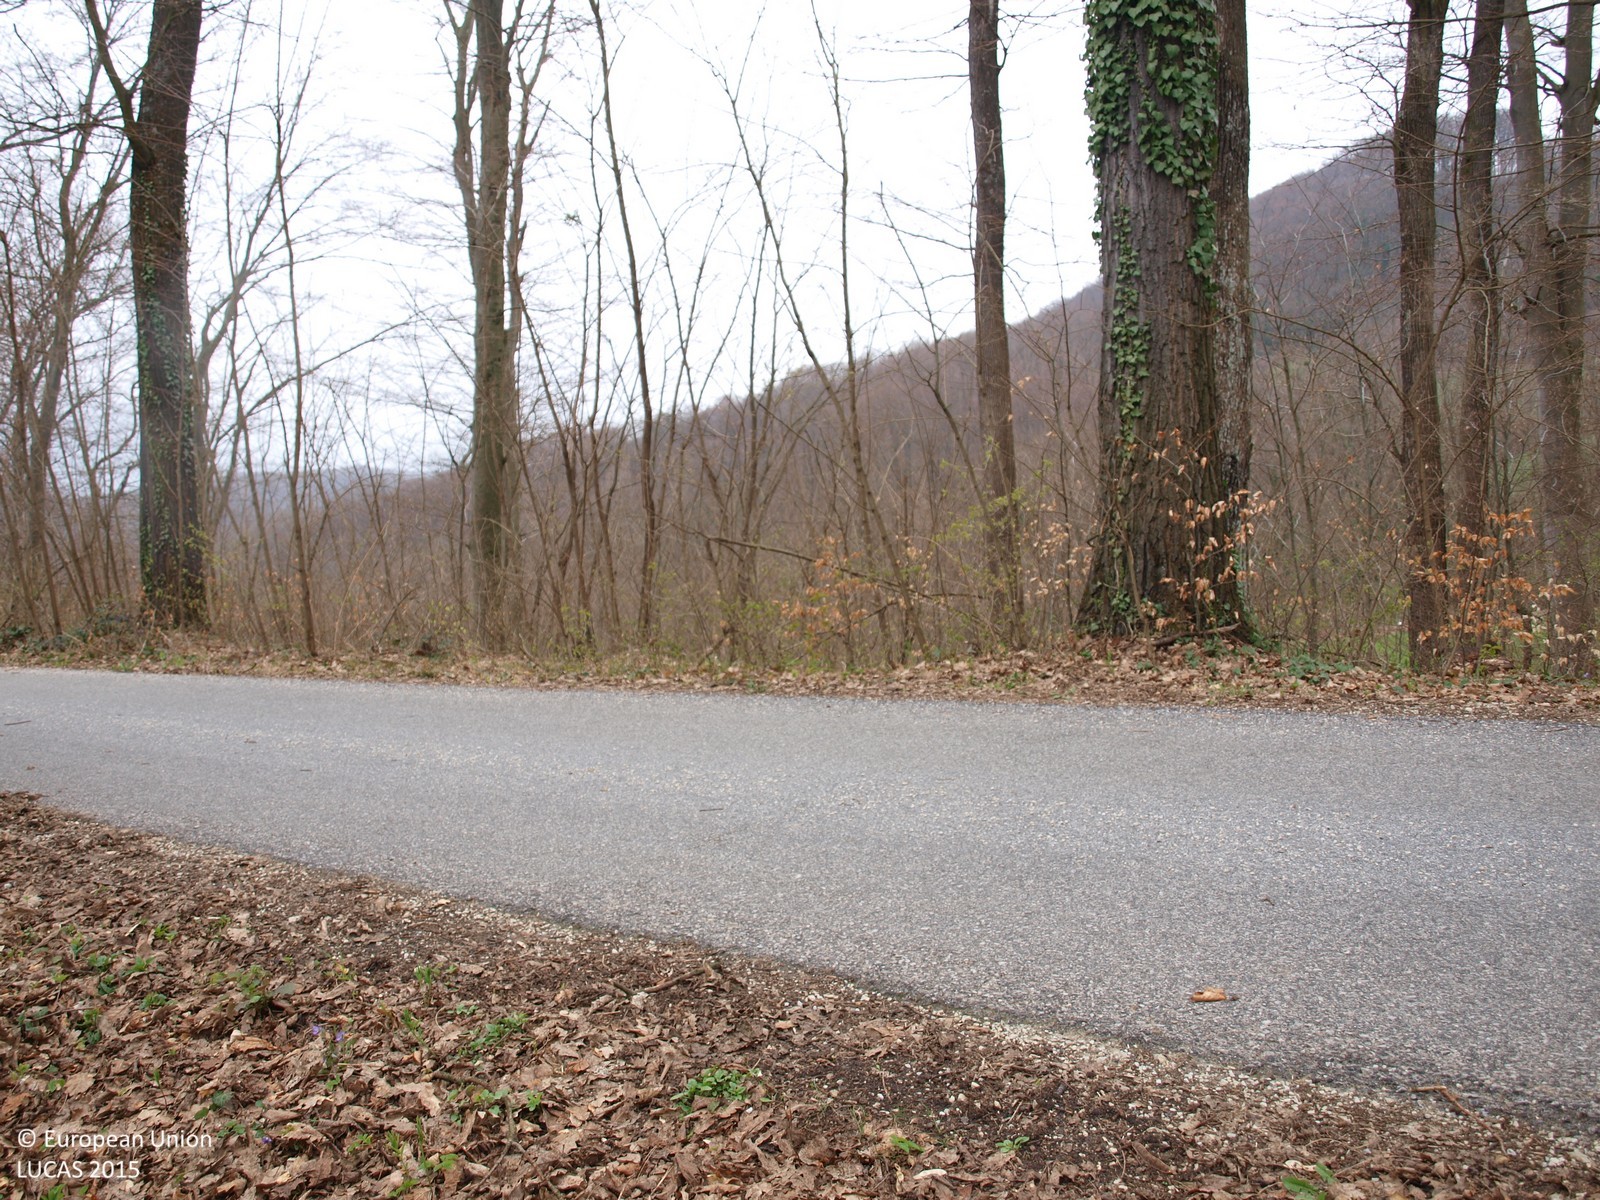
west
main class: Woodland
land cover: Broadleaved woodland
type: mesophytic deciduous forest
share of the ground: > 75 %
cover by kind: broadleaved forest trees 90 %
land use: Forestry
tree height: > 5 m
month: April
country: HR
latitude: 46.1806
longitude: 15.7113
